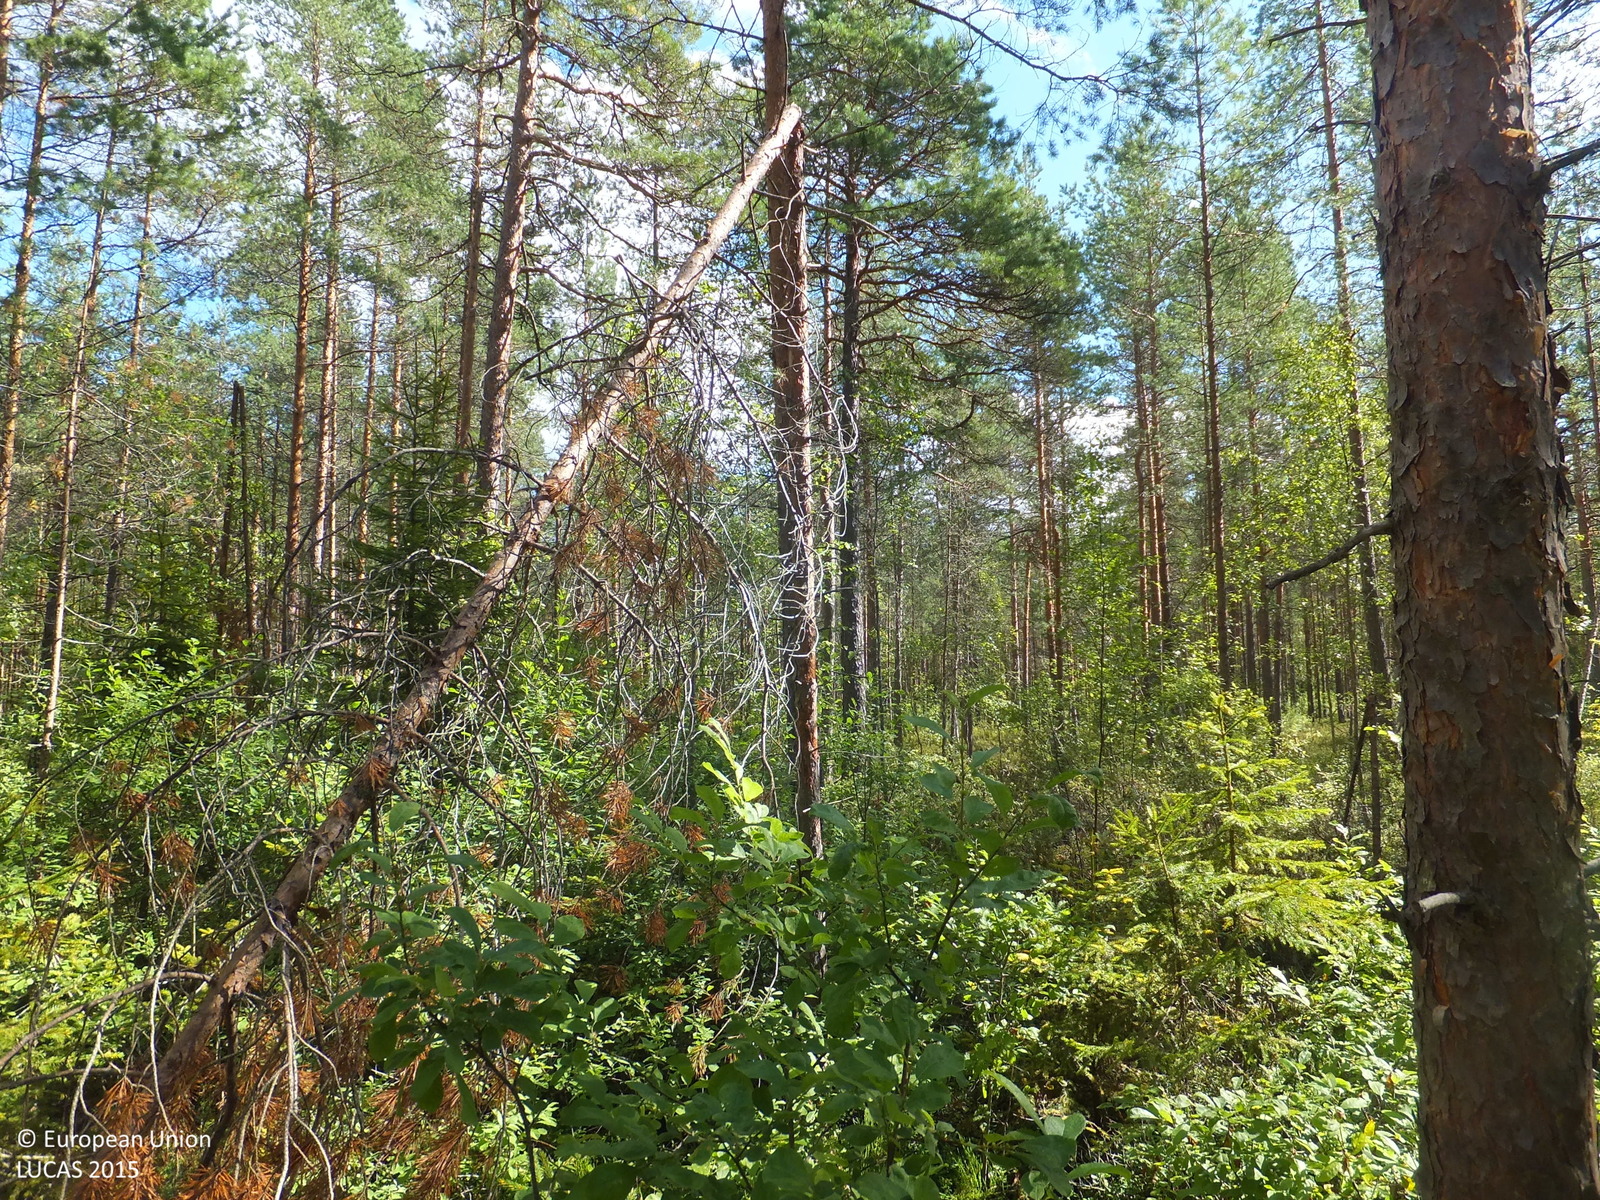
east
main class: Woodland
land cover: Pine dominated coniferous woodland
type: boreal forest
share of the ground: > 75 %
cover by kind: coniferous forest trees 75 %, shrubs 10 %, lichens and mosses 10 %, broadleaved forest trees 5 %
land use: Forestry
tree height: > 5 m
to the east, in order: Pine dominated coniferous woodland; Tracks; Pine dominated coniferous woodland; Other mixed woodland; Ditches and canals; Other mixed woodland
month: August
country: FI
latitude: 63.2645
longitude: 23.1082
